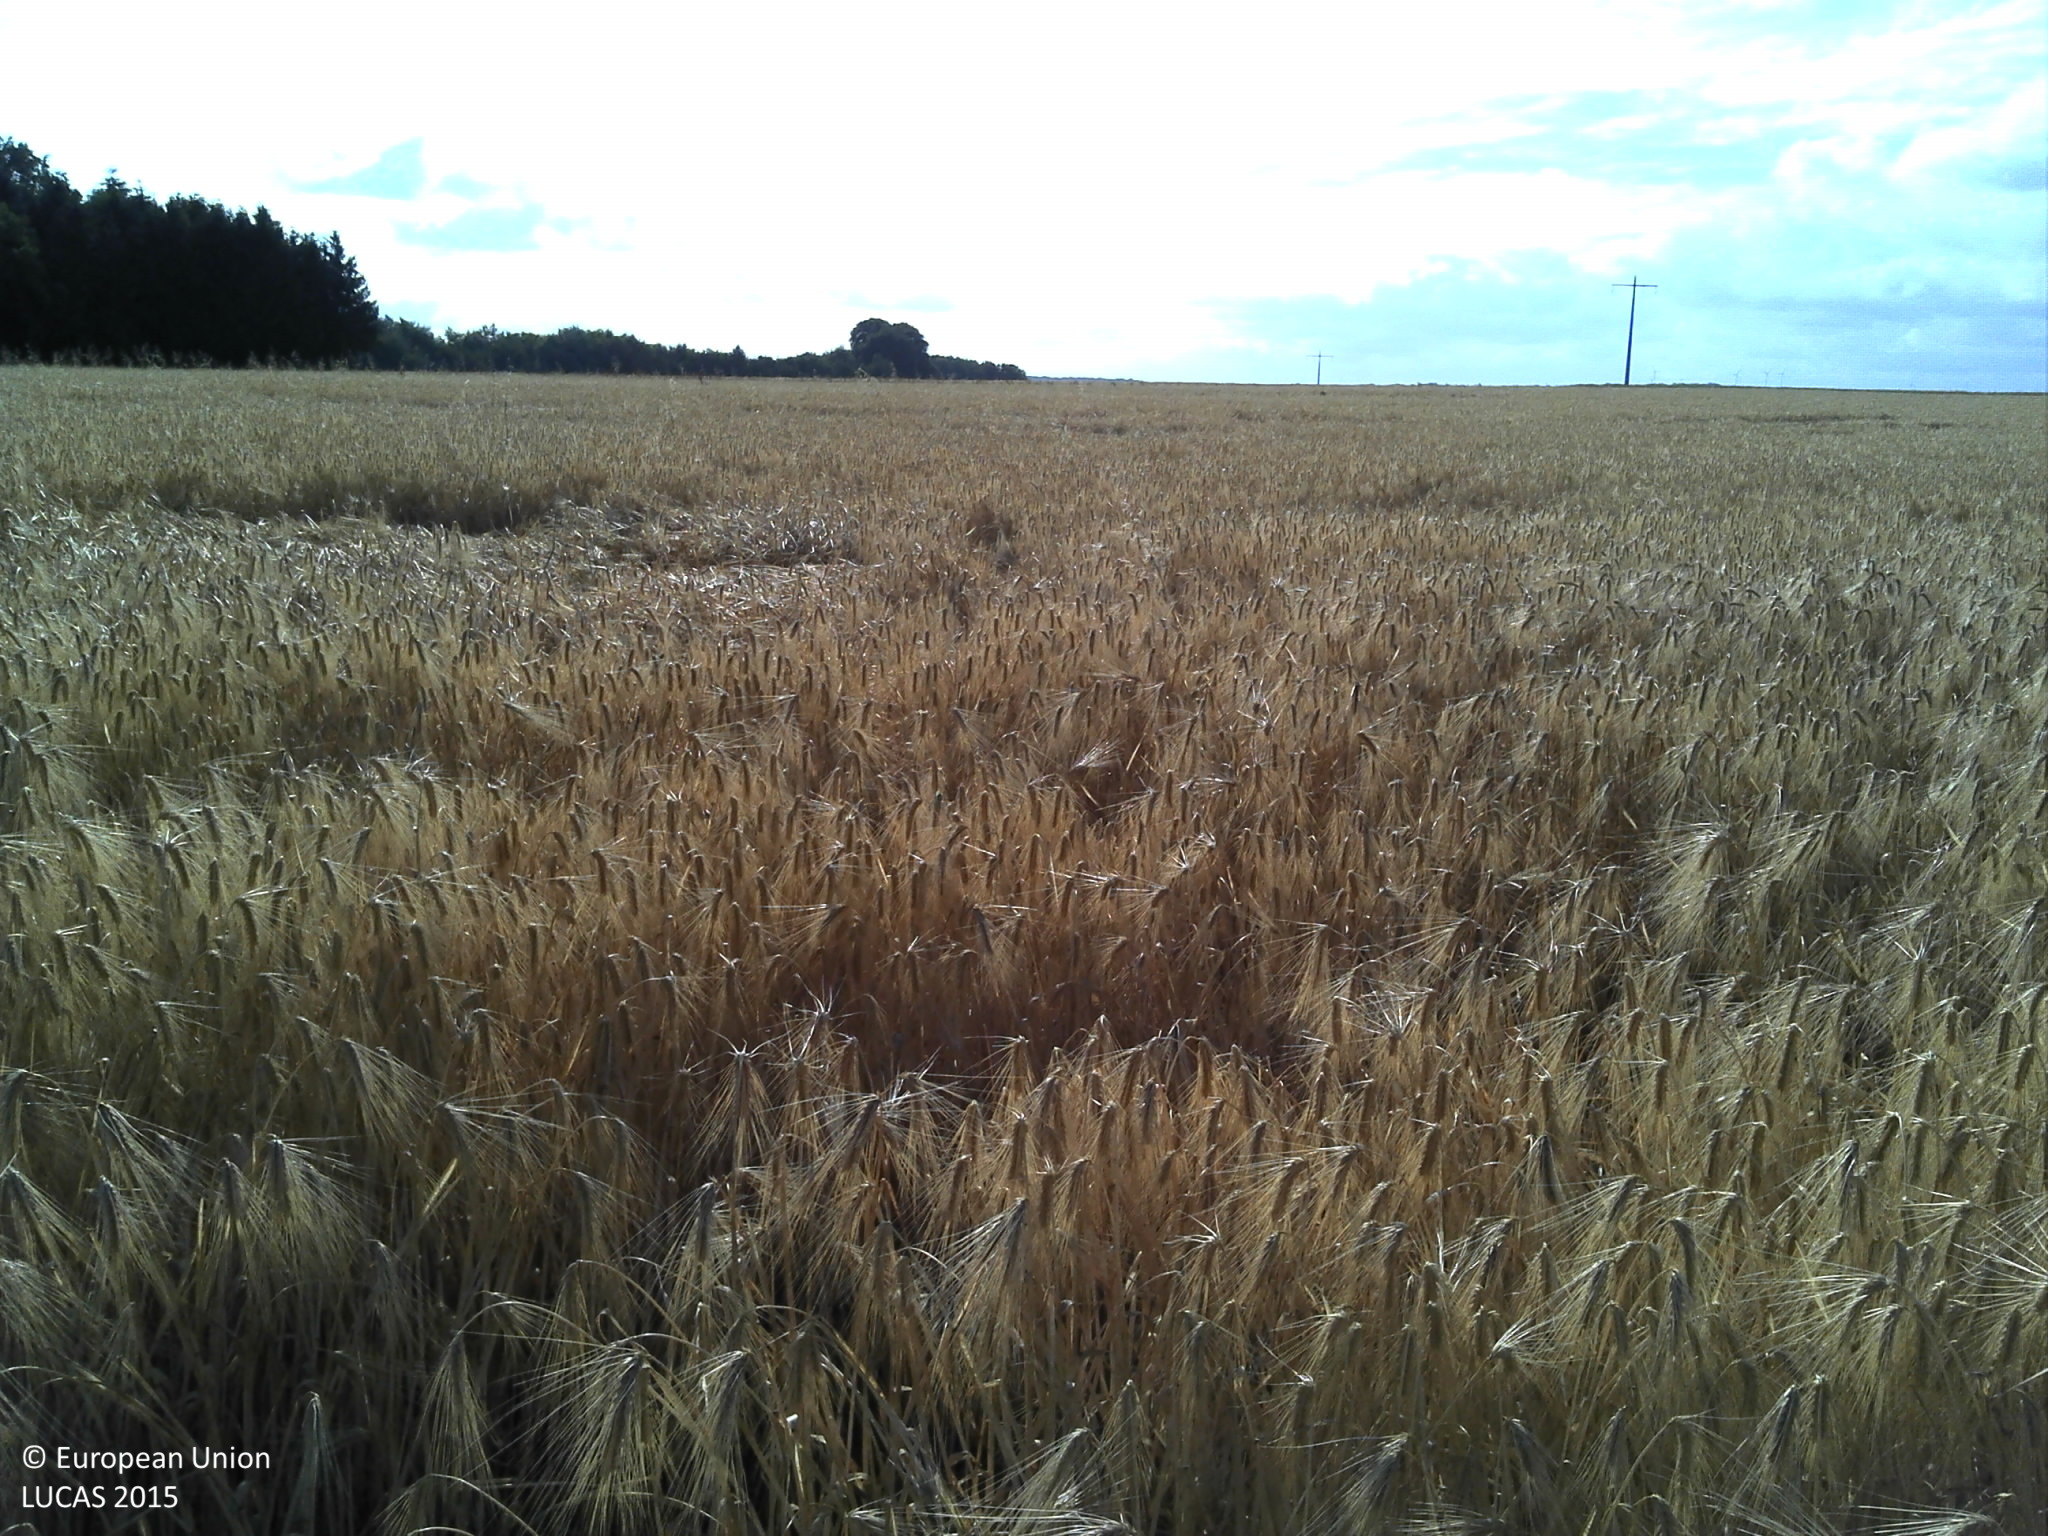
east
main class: Cropland
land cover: Barley
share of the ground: > 75 %
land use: Agriculture (excluding fallow land and kitchen gardens)
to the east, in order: Barley; Grass margins; Tracks; Grass margins; Oats
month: July
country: LU
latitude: 49.5296
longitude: 6.2830
